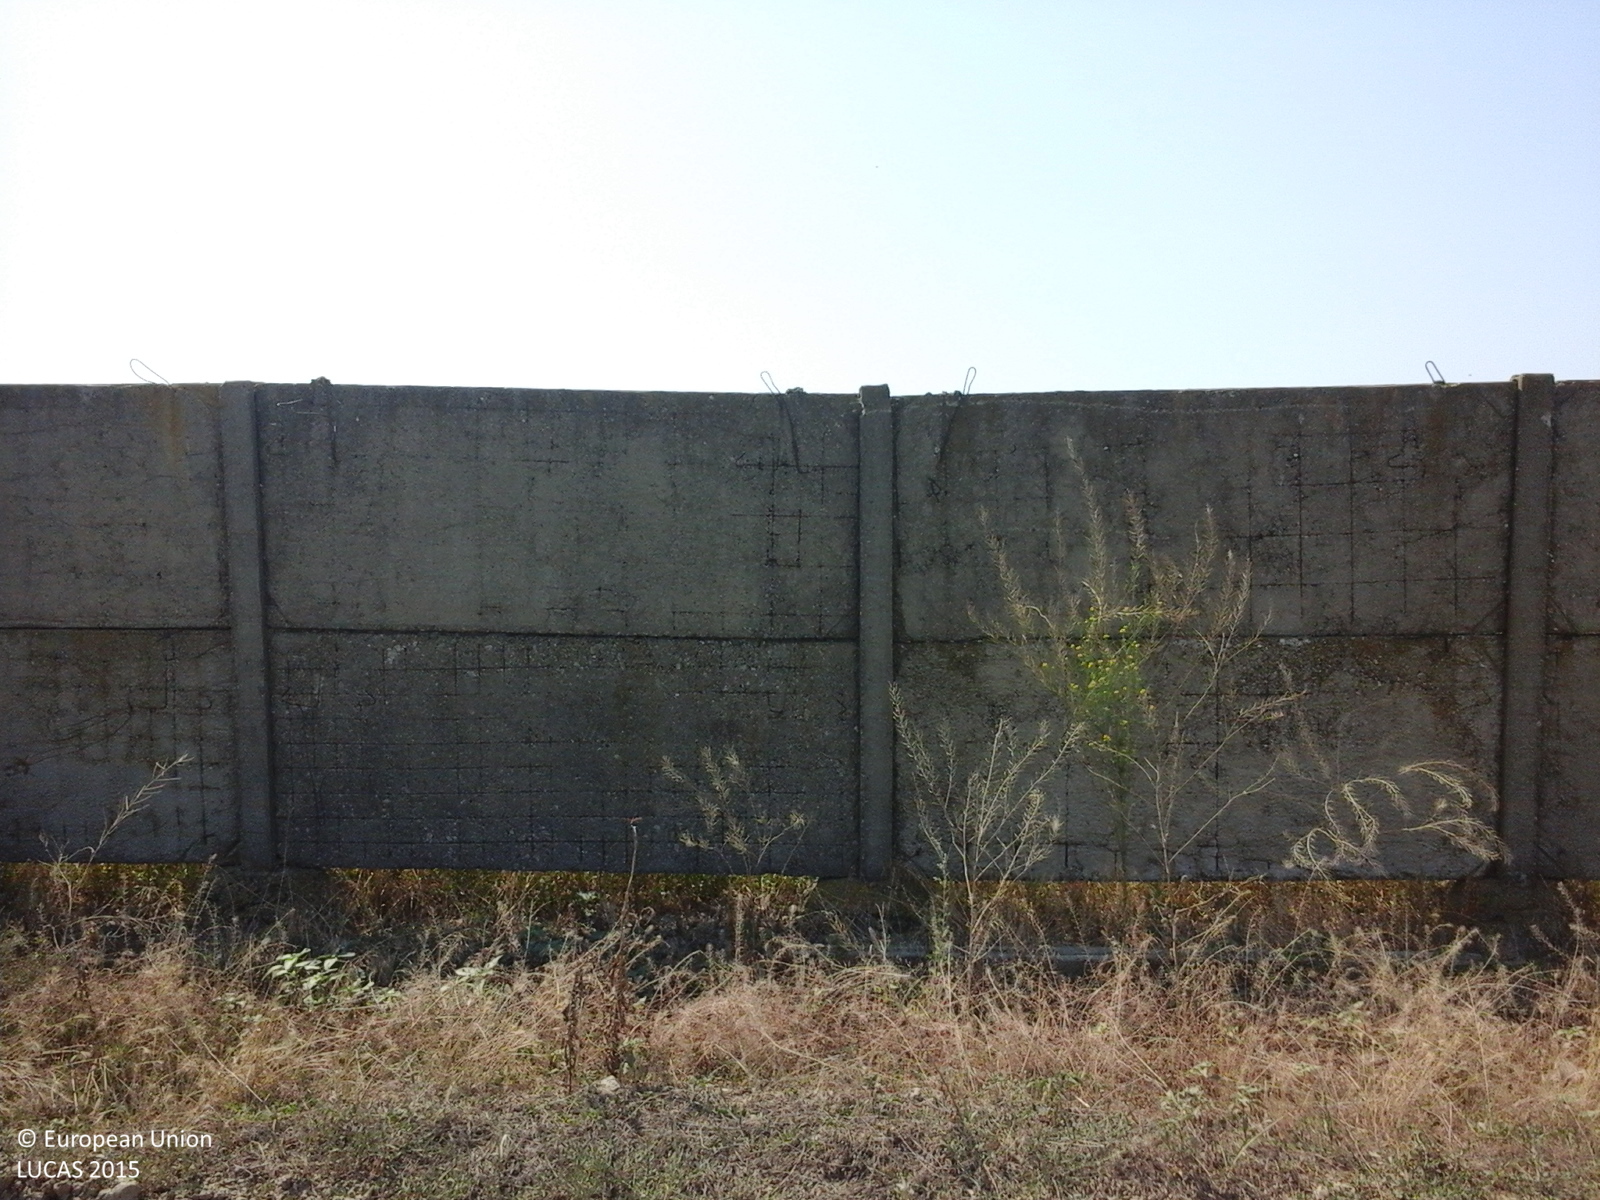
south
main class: Cropland
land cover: Soya
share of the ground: > 75 %
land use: Agriculture (excluding fallow land and kitchen gardens)
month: August
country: RO
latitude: 45.1342
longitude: 28.0314
